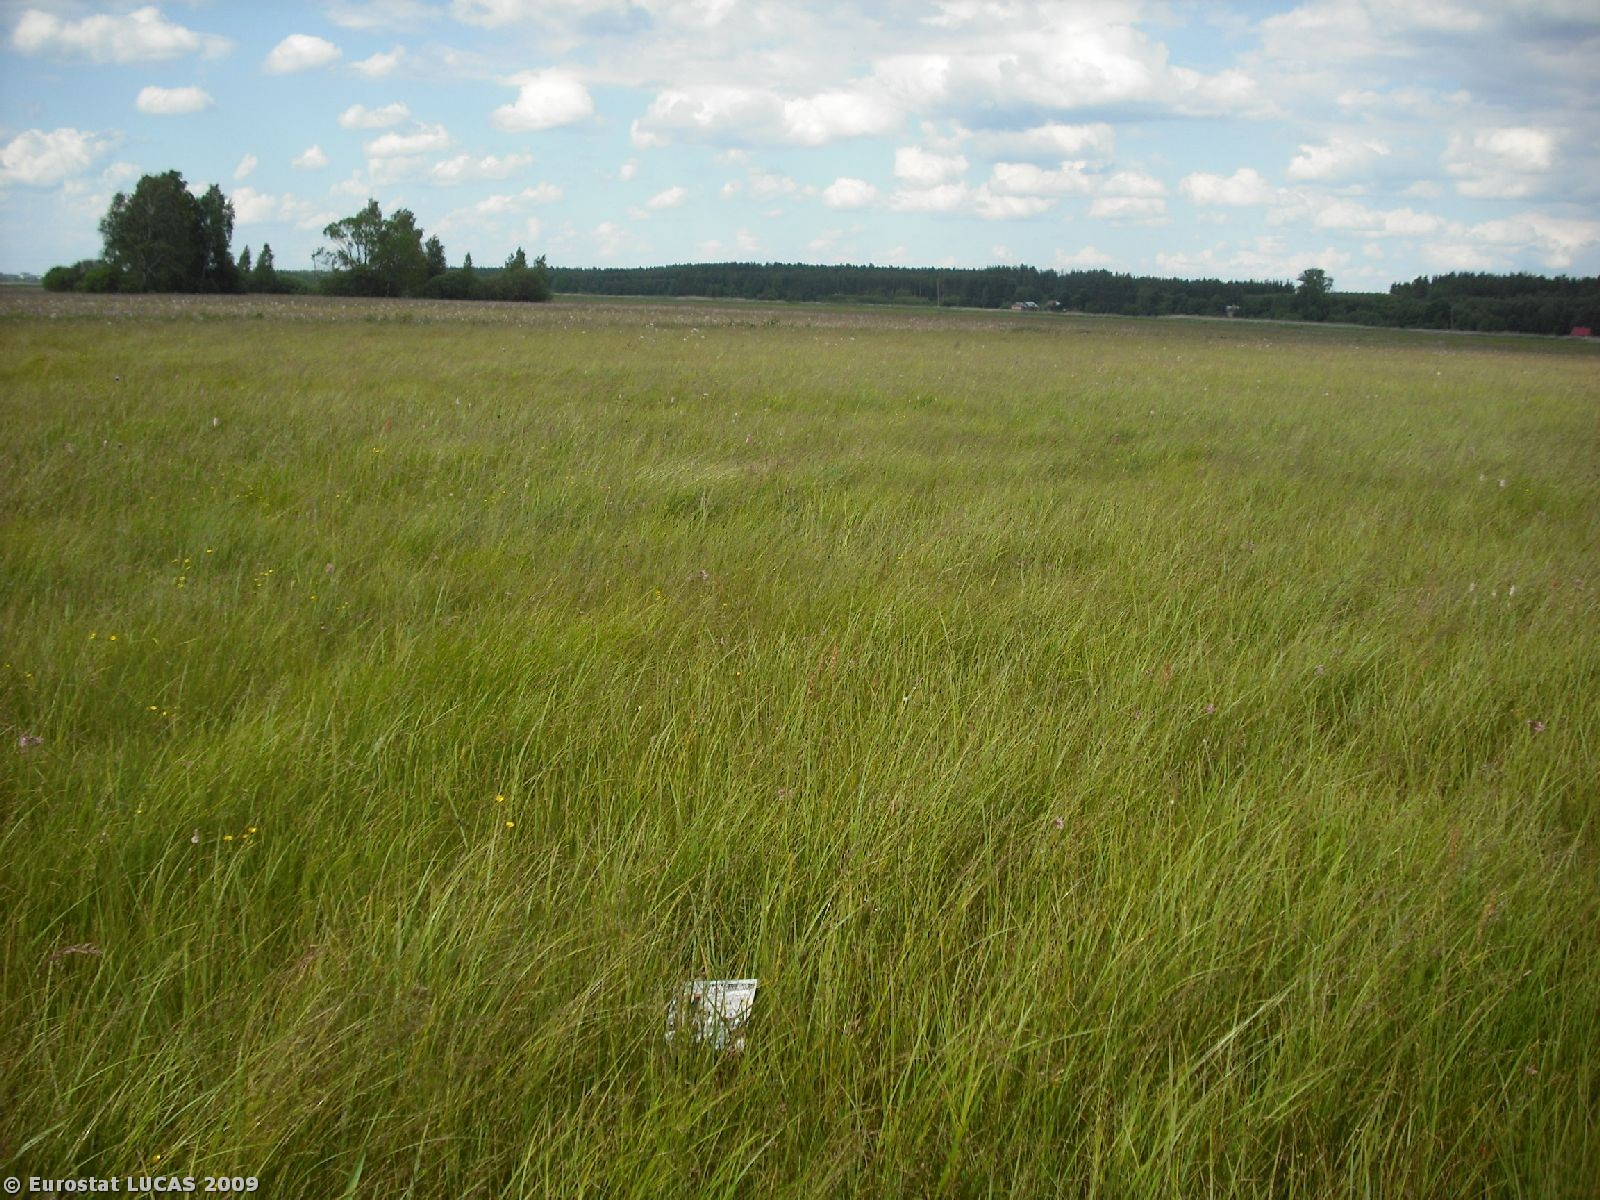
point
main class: Grassland
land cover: Grassland without tree/shrub cover
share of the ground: > 75 %
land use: Agriculture (excluding fallow land and kitchen gardens)
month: June
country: PL
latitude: 53.6722
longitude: 23.4174
